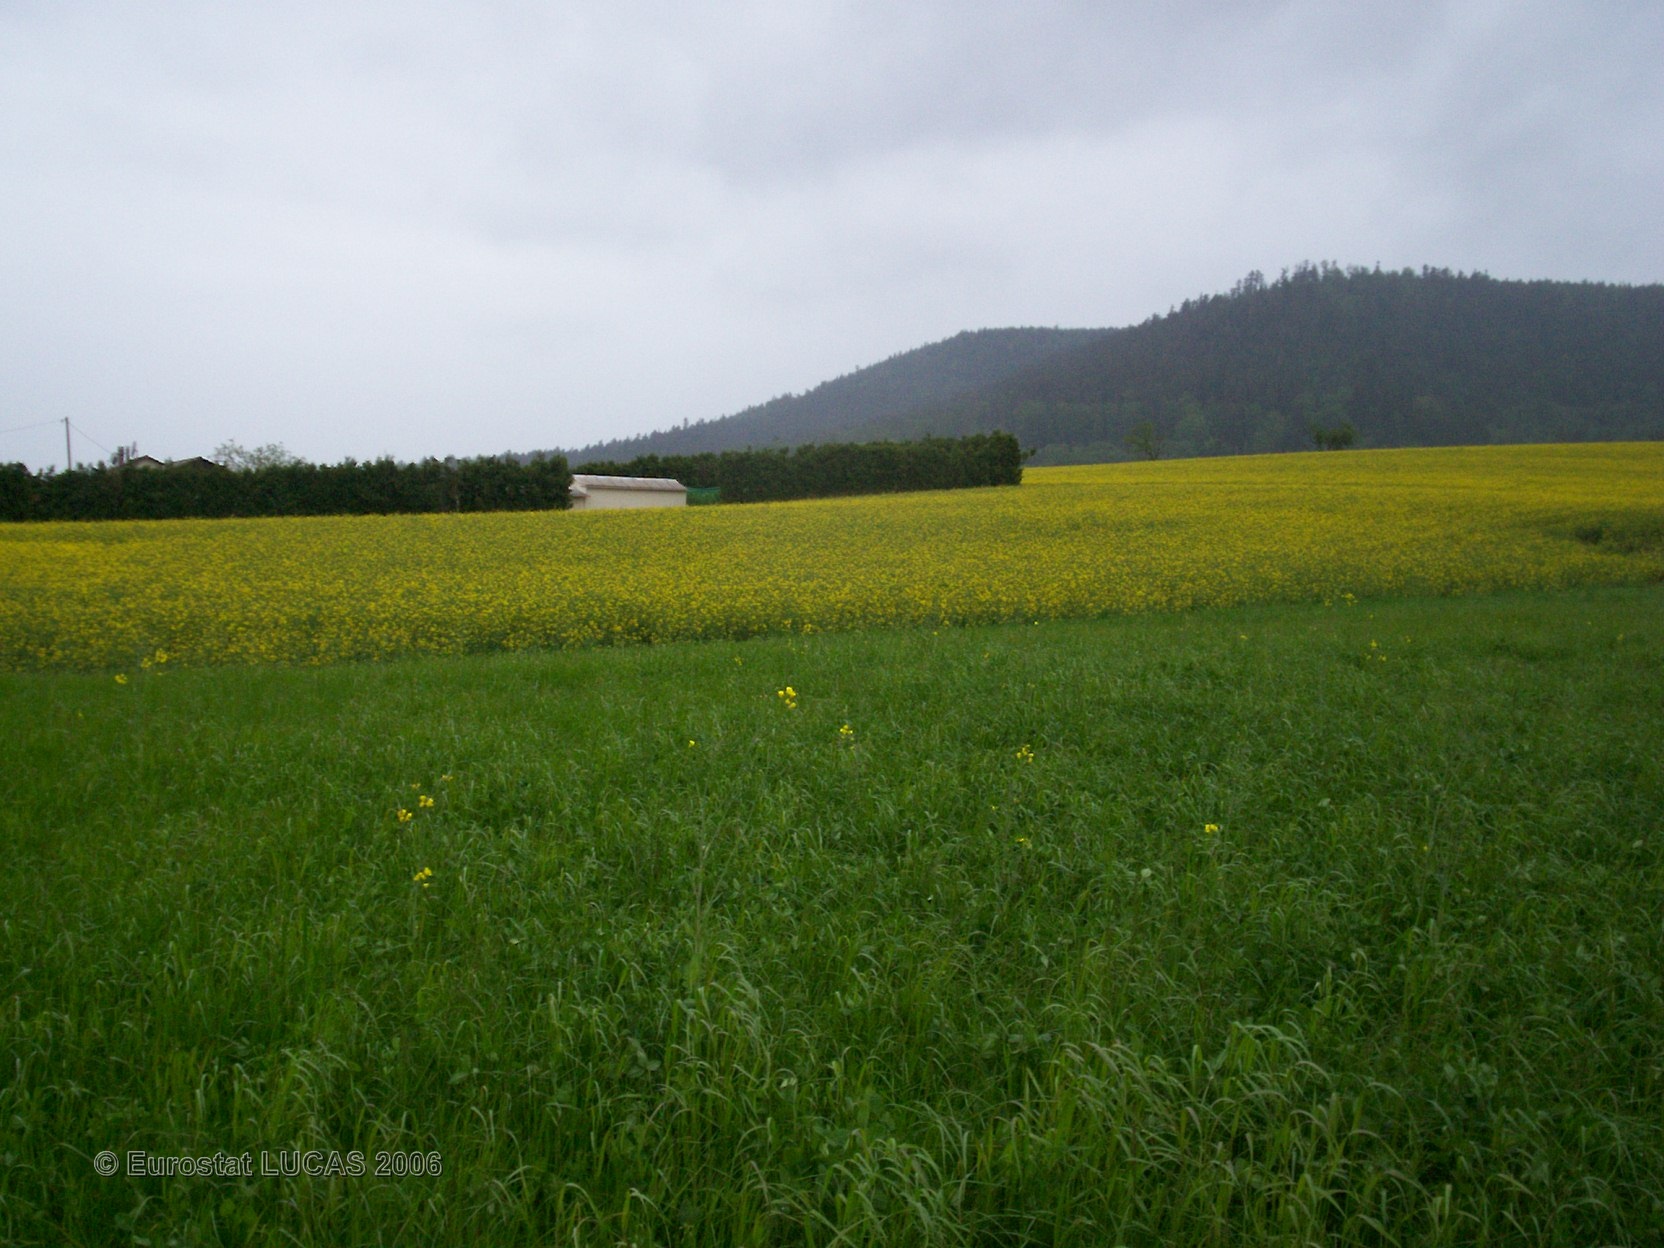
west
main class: Cropland
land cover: Other leguminous and mixtures for fodder
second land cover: Clovers
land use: Agriculture (excluding fallow land and kitchen gardens)
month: May
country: FR
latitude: 48.1947
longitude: 6.7856
